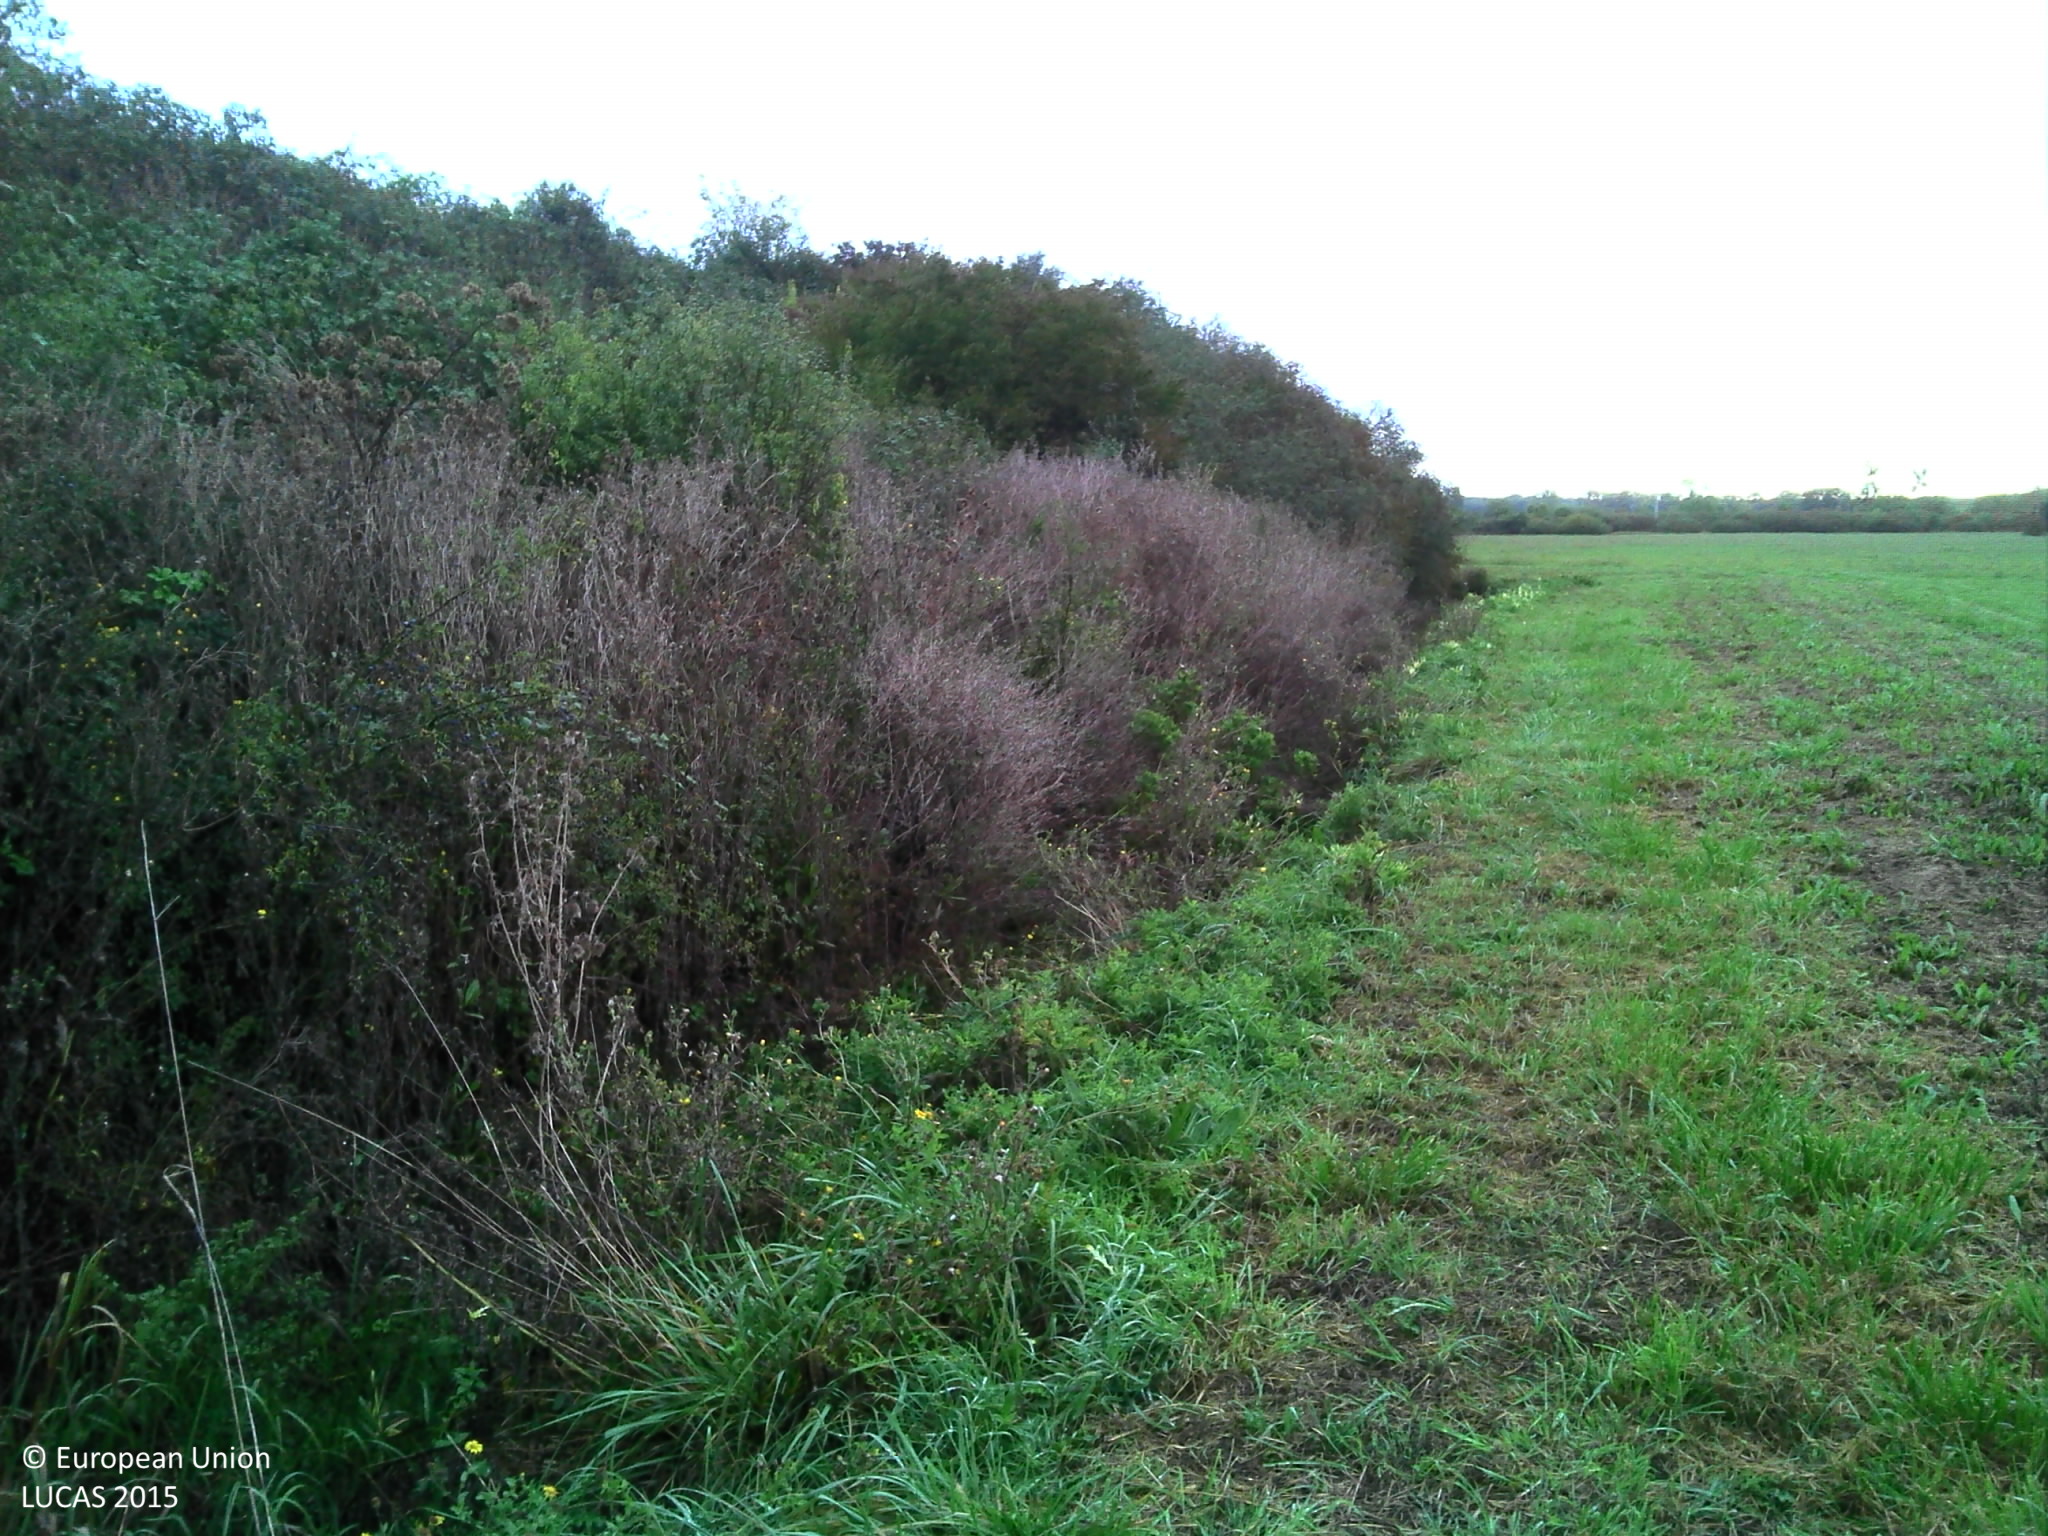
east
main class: Grassland
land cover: Grassland without tree/shrub cover
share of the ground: > 75 %
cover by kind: herbaceous plants 100 %
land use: Agriculture (excluding fallow land and kitchen gardens)
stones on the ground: < 10 %
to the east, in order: Grassland without tree/shrub cover; Ditches and canals; Shrubland without tree cover; Grassland without tree/shrub cover; Shrubland without tree cover; Ditches and canals; Grassland without tree/shrub cover; Other bare soil
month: October
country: FR
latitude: 48.2702
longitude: 4.2169
